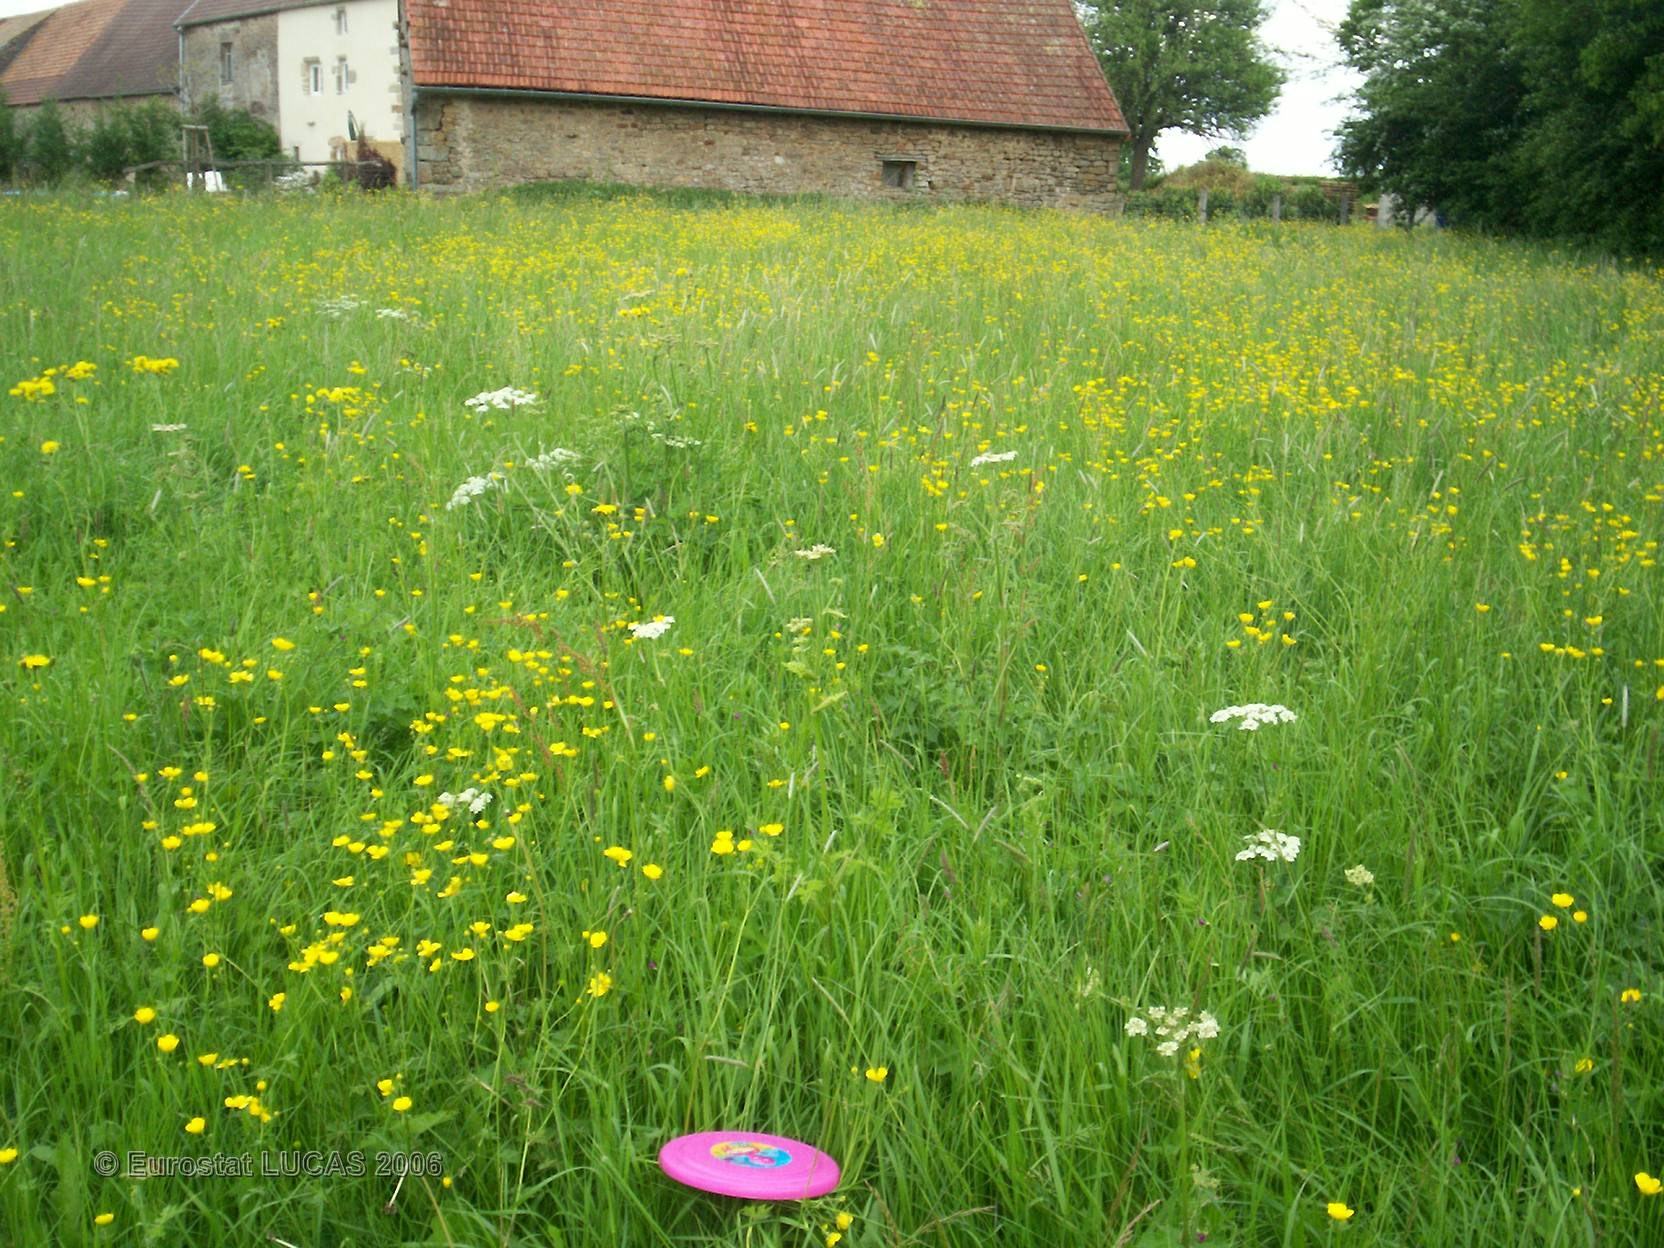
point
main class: Grassland
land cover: Grassland without tree/shrub cover
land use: Agriculture (excluding fallow land and kitchen gardens)
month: May
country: FR
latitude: 47.0804
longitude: 4.5869
